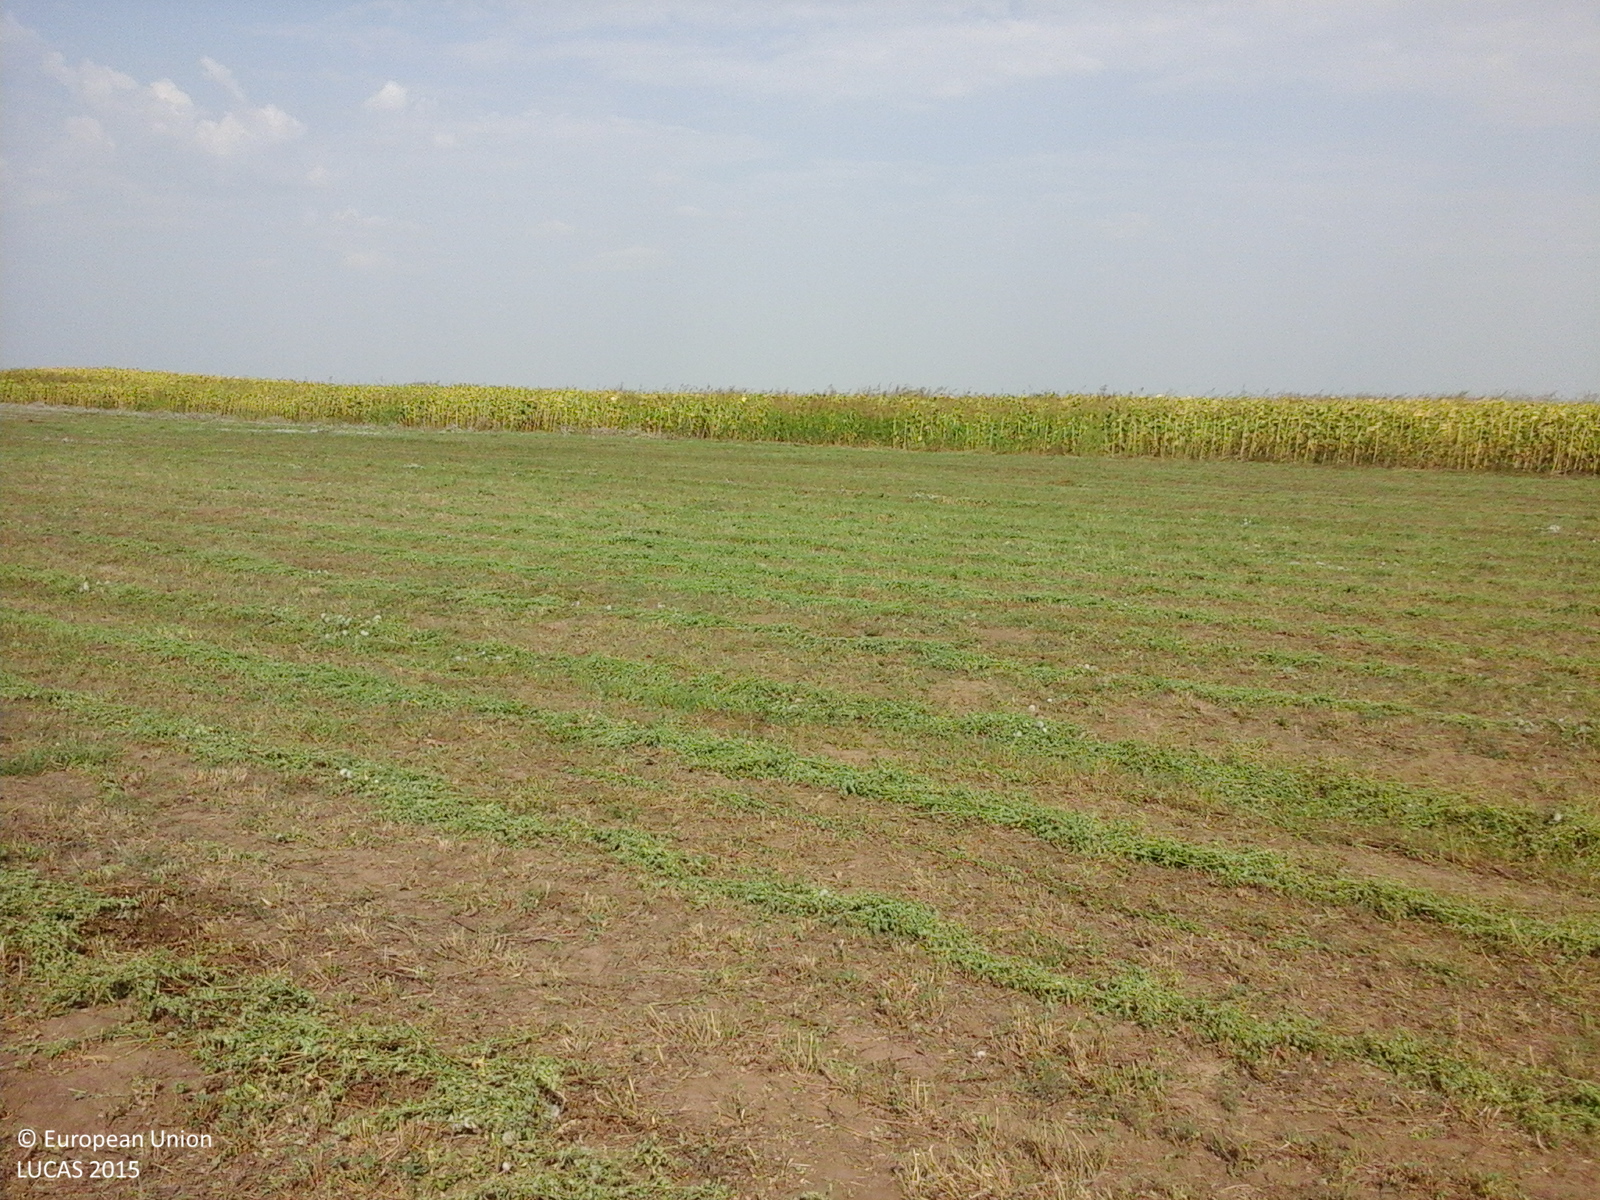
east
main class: Cropland
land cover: Lucerne
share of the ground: 50 - 75 %
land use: Agriculture (excluding fallow land and kitchen gardens)
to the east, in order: Lucerne; Sunflower; Common wheat
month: August
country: RO
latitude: 45.2846
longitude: 27.4767
